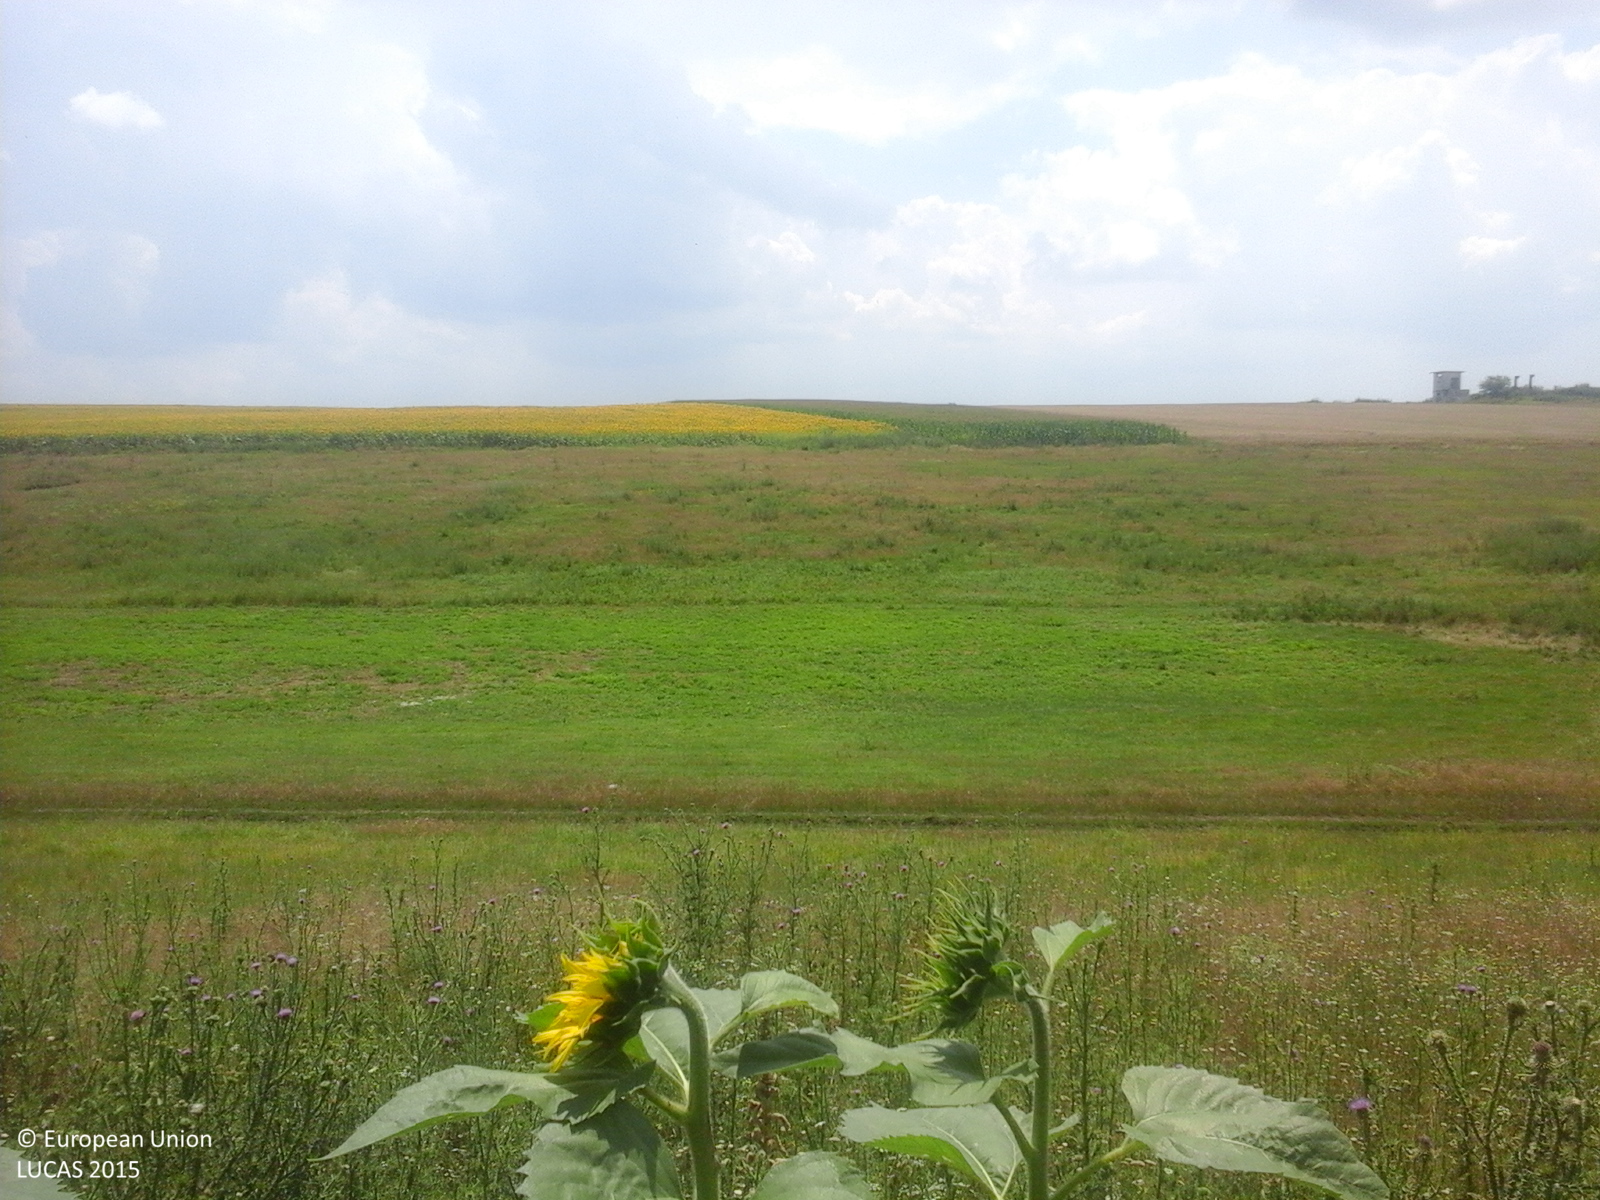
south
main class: Cropland
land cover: Sunflower
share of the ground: > 75 %
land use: Agriculture (excluding fallow land and kitchen gardens)
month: July
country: RO
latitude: 43.8928
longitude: 25.7387
